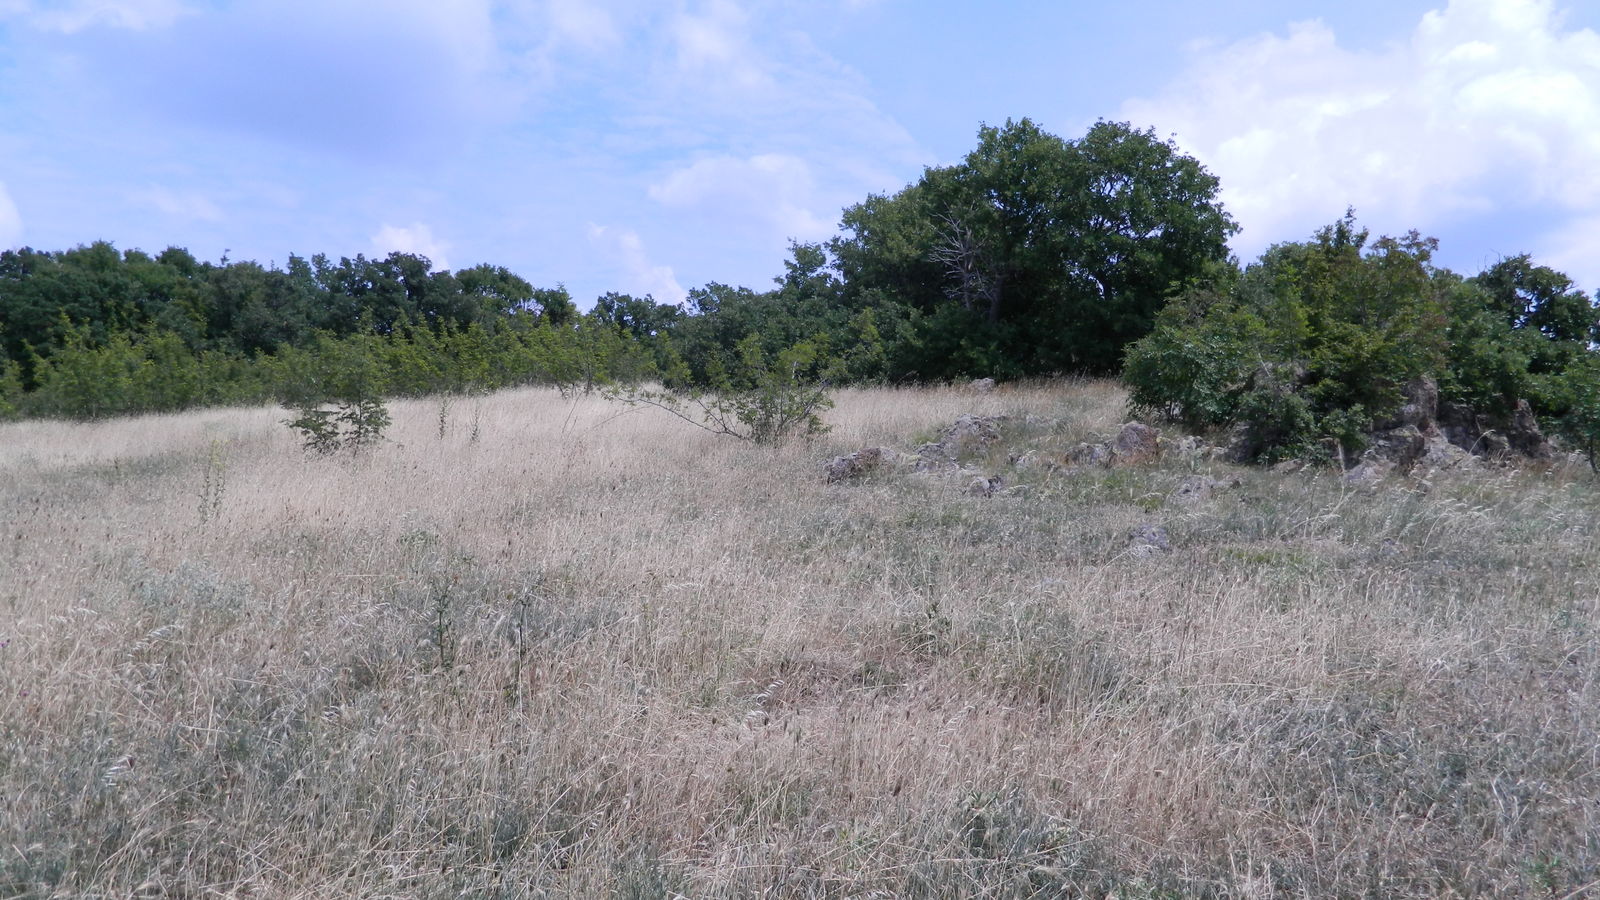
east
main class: Grassland
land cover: Grassland with sparse tree/shrub cover
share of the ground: > 75 %
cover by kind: herbaceous plants 90 %, broadleaved forest trees 5 %, shrubs 5 %
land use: Semi-natural and natural areas not in use
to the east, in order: Grassland with sparse tree/shrub cover; Rock outcrops; Broadleaved woodland; Rock outcrops; Broadleaved woodland; Rock outcrops; Broadleaved woodland
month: June
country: BG
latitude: 41.8794
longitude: 25.3511
